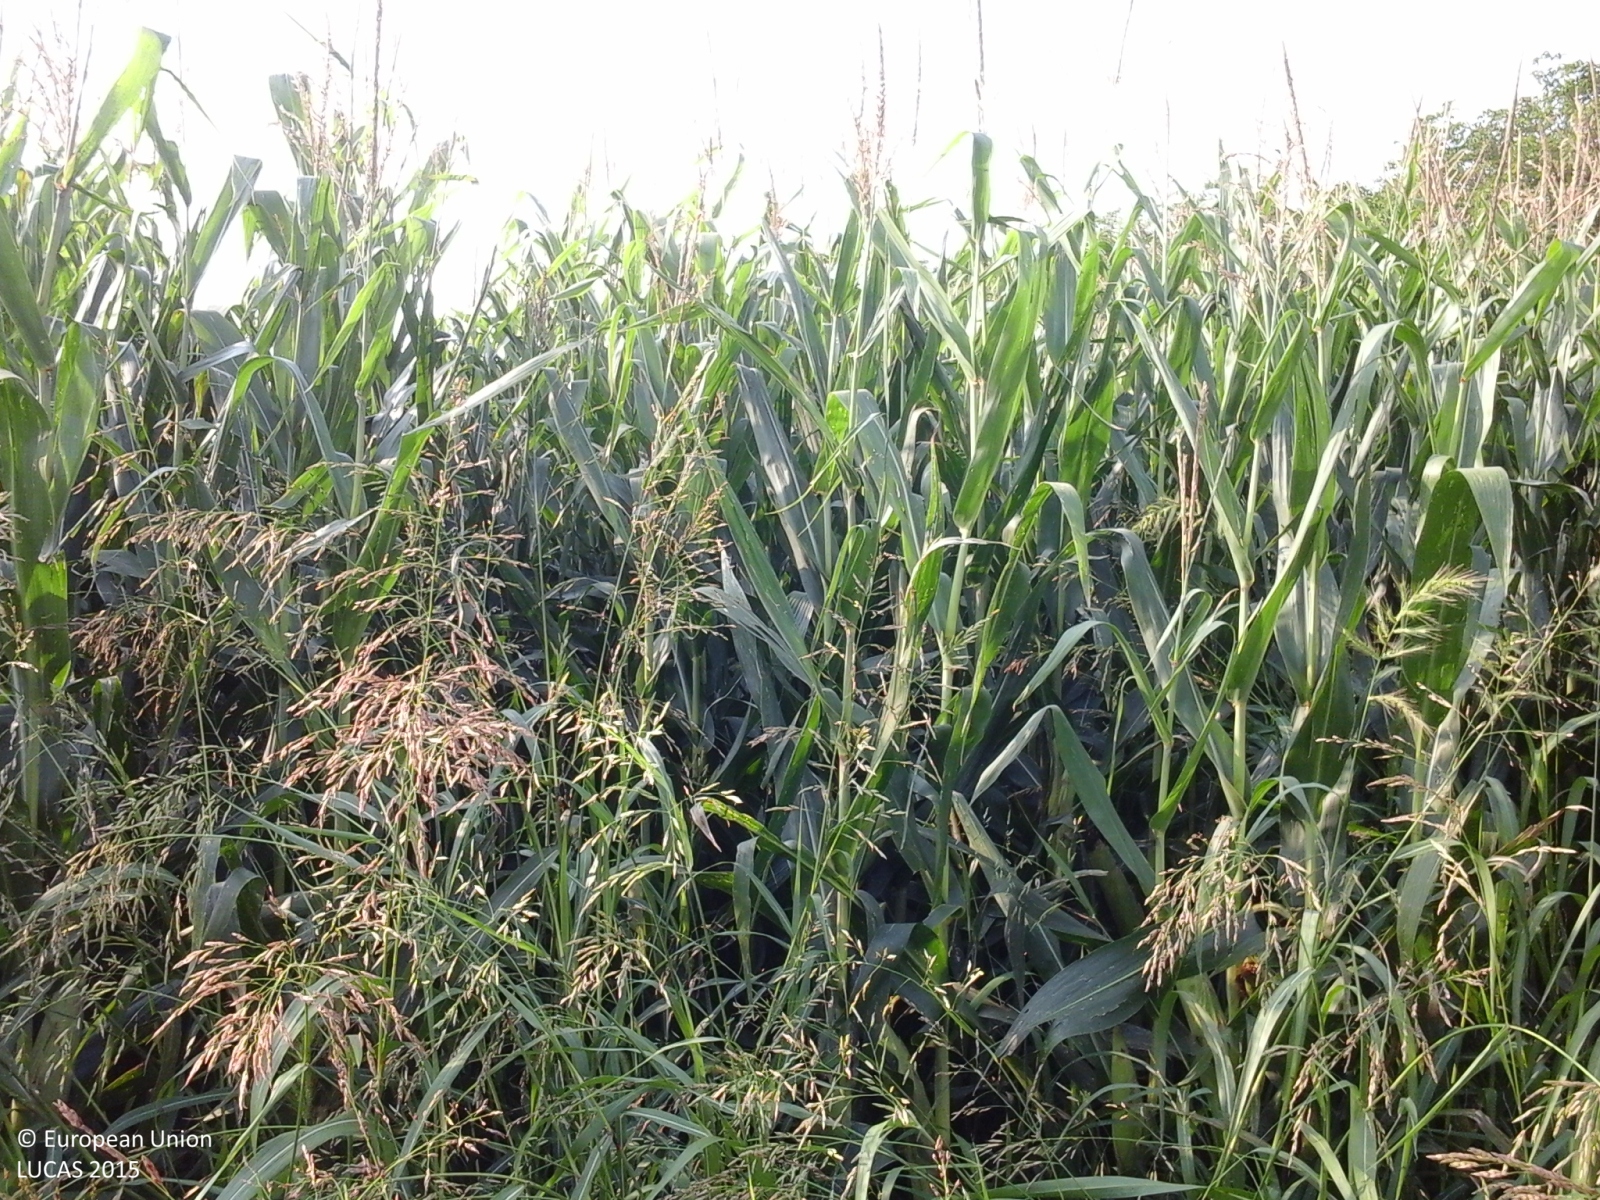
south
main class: Cropland
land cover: Maize
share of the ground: > 75 %
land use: Agriculture (excluding fallow land and kitchen gardens)
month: June
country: IT
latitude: 45.9276
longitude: 12.4083
